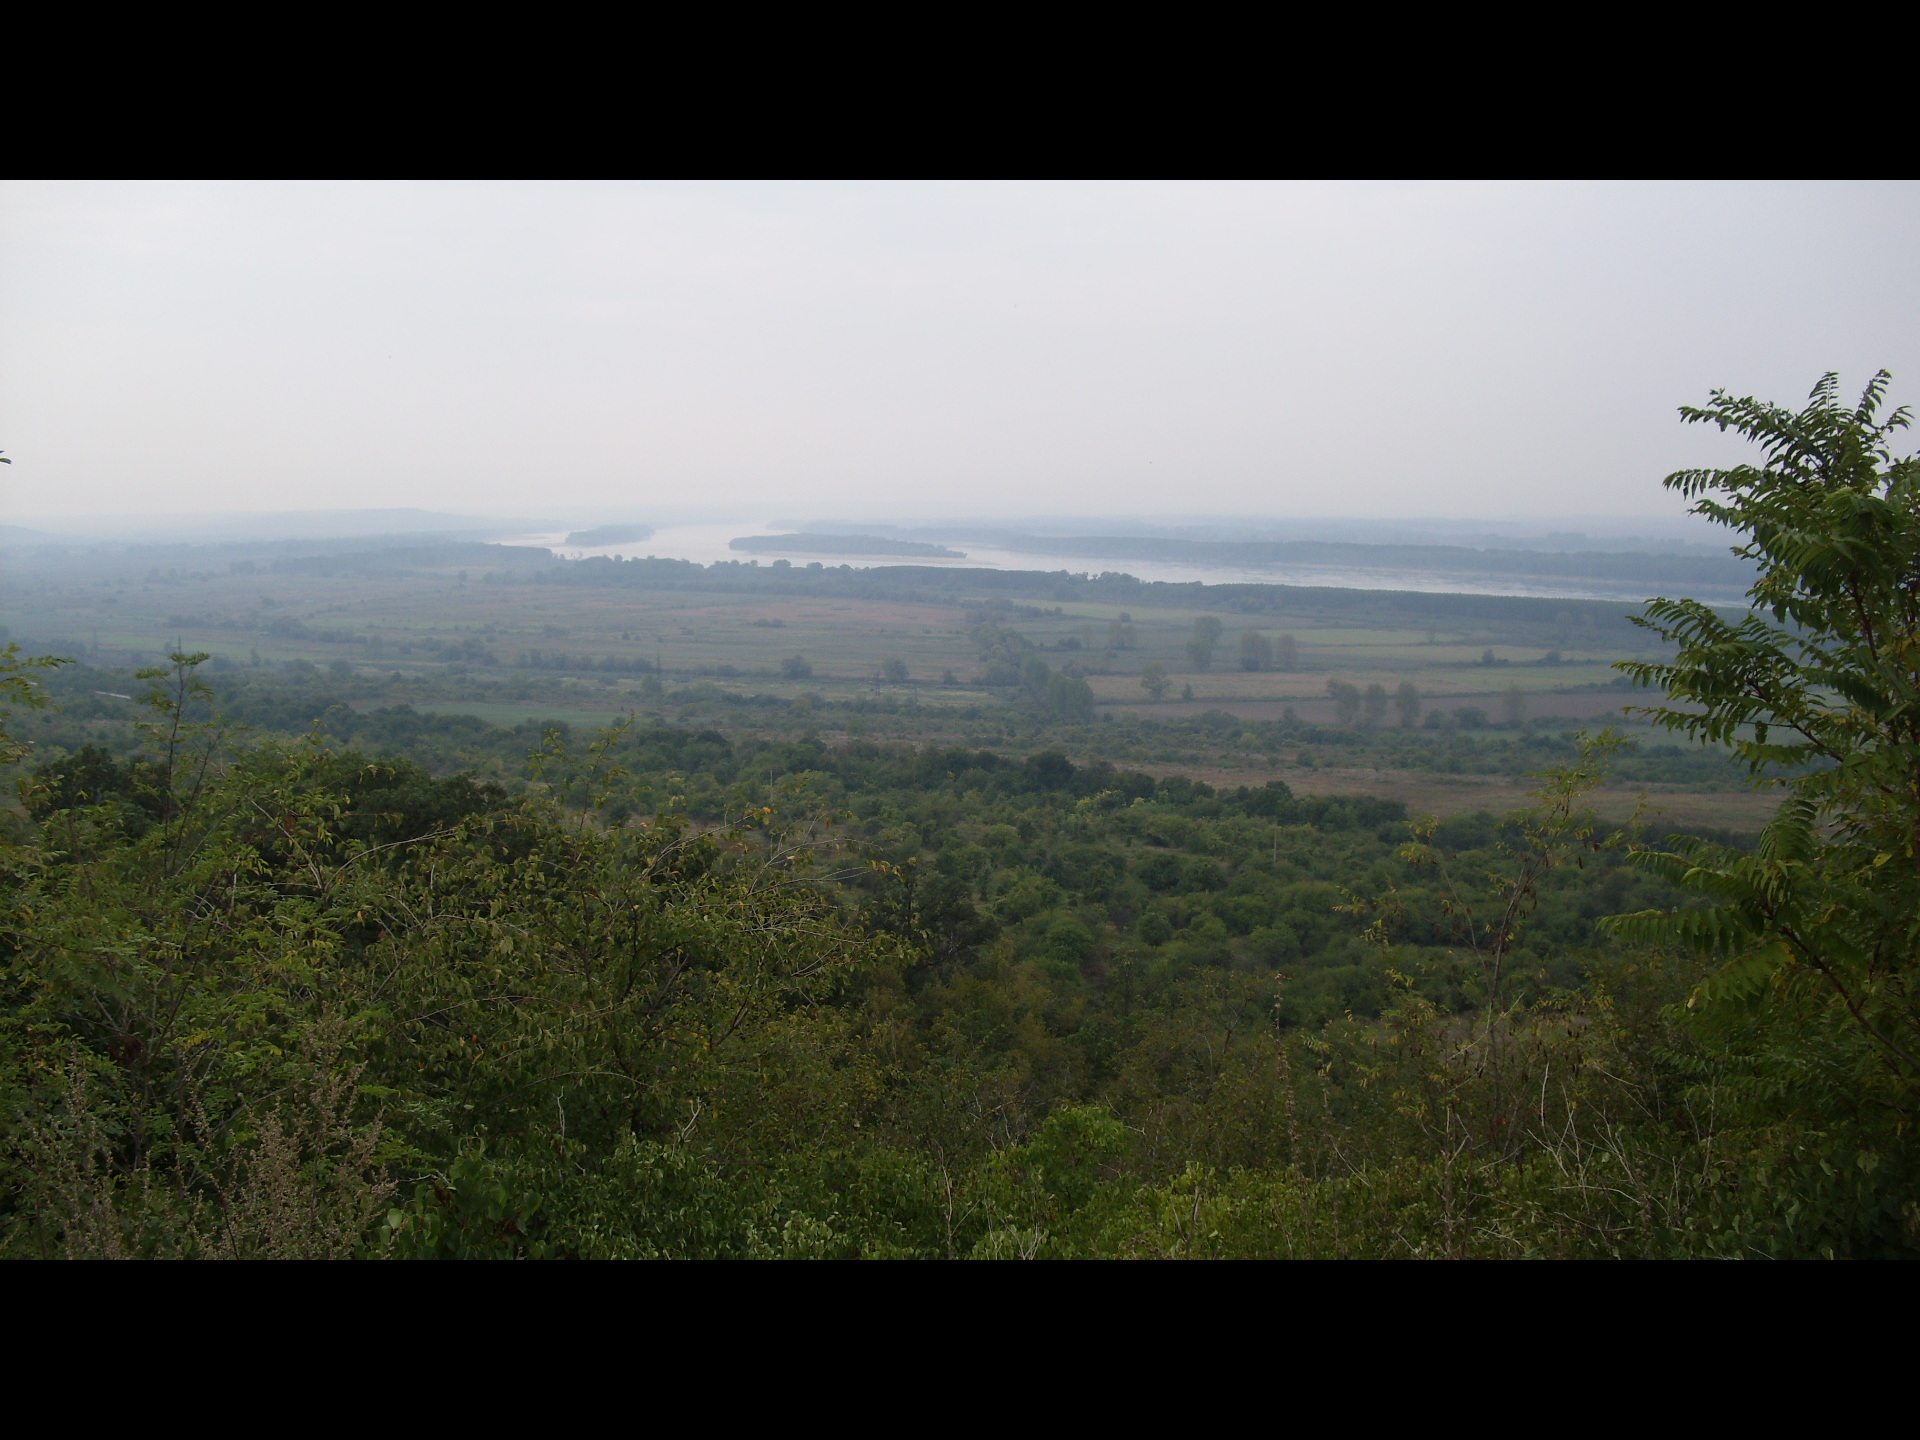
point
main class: Woodland
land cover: Broadleaved woodland
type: mesophytic deciduous forest
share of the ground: > 75 %
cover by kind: broadleaved forest trees 95 %, coniferous forest trees 5 %
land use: Semi-natural and natural areas not in use
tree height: > 5 m
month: September
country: BG
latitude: 43.7865
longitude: 23.1265
